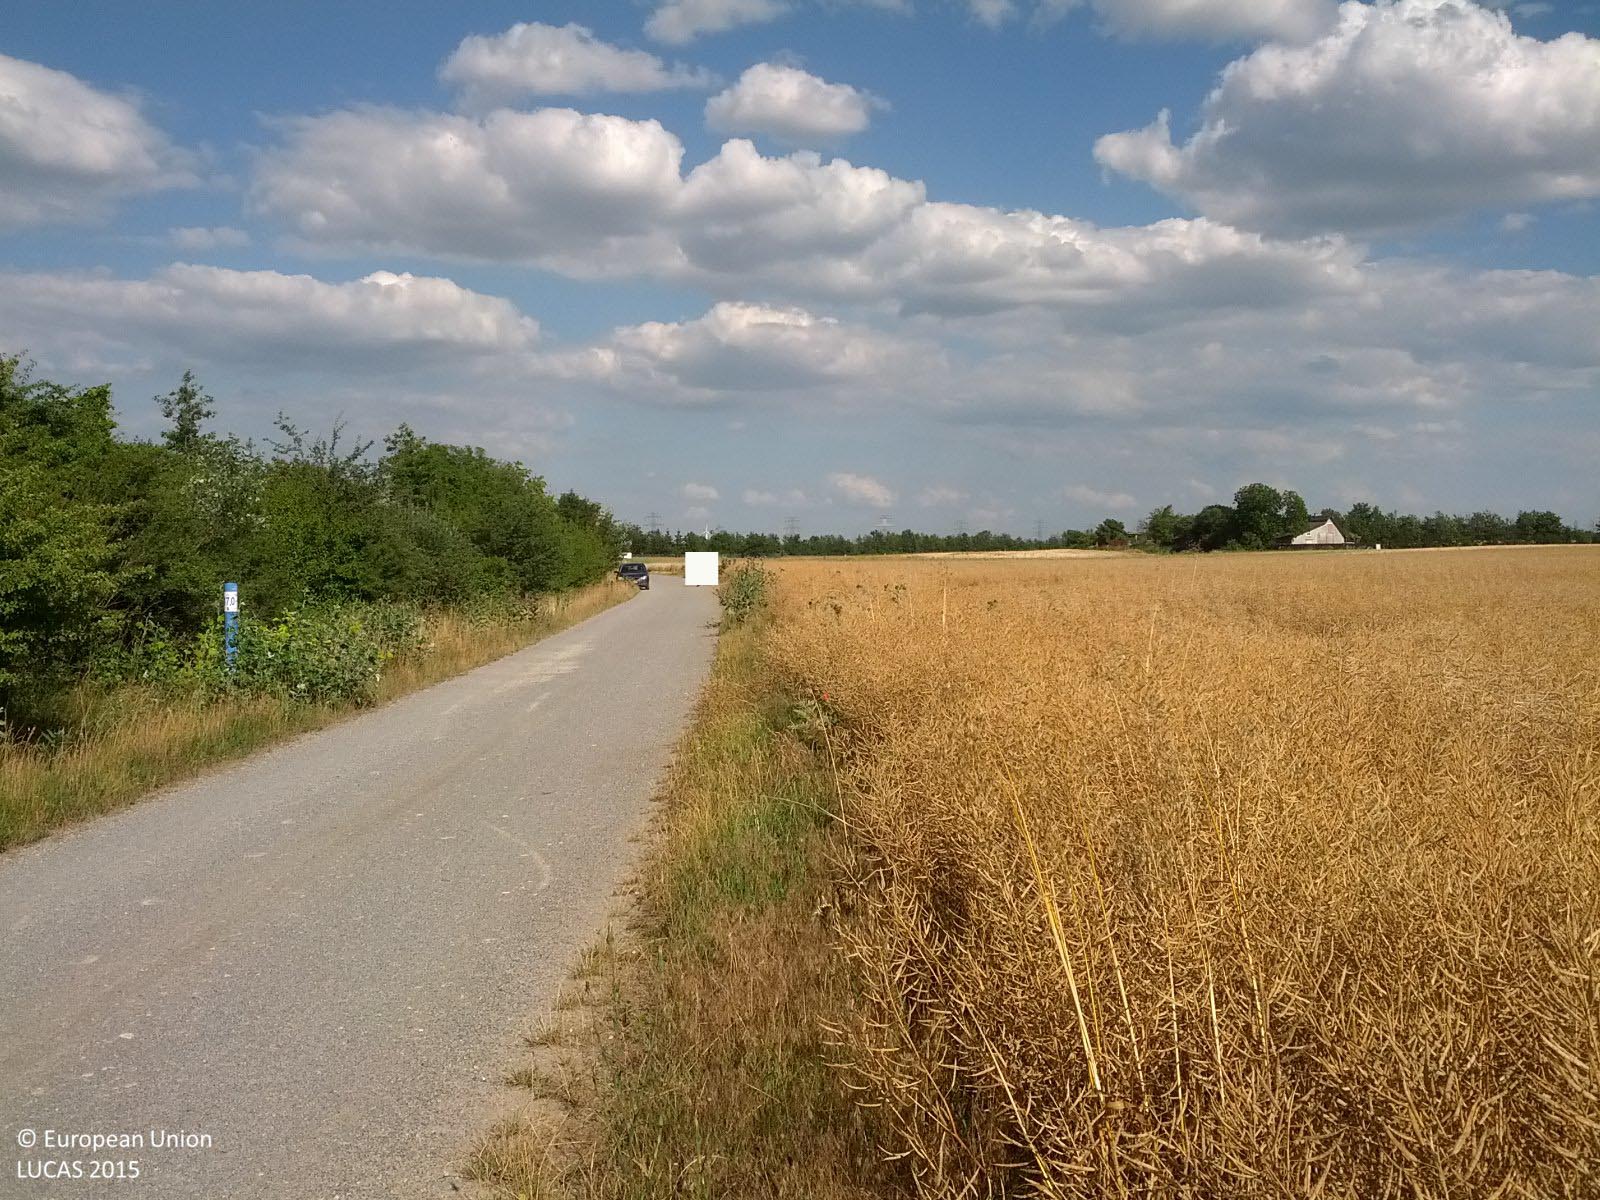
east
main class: Cropland
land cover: Rape and turnip rape
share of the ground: > 75 %
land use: Agriculture (excluding fallow land and kitchen gardens)
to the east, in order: Rape and turnip rape; Grass margins; Paved roads, cycling and walking lanes; Grass margins; Shrubland with sparse tree cover; Inland fresh running water; Broadleaved woodland
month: June
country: AT
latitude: 48.3015
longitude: 16.5171
